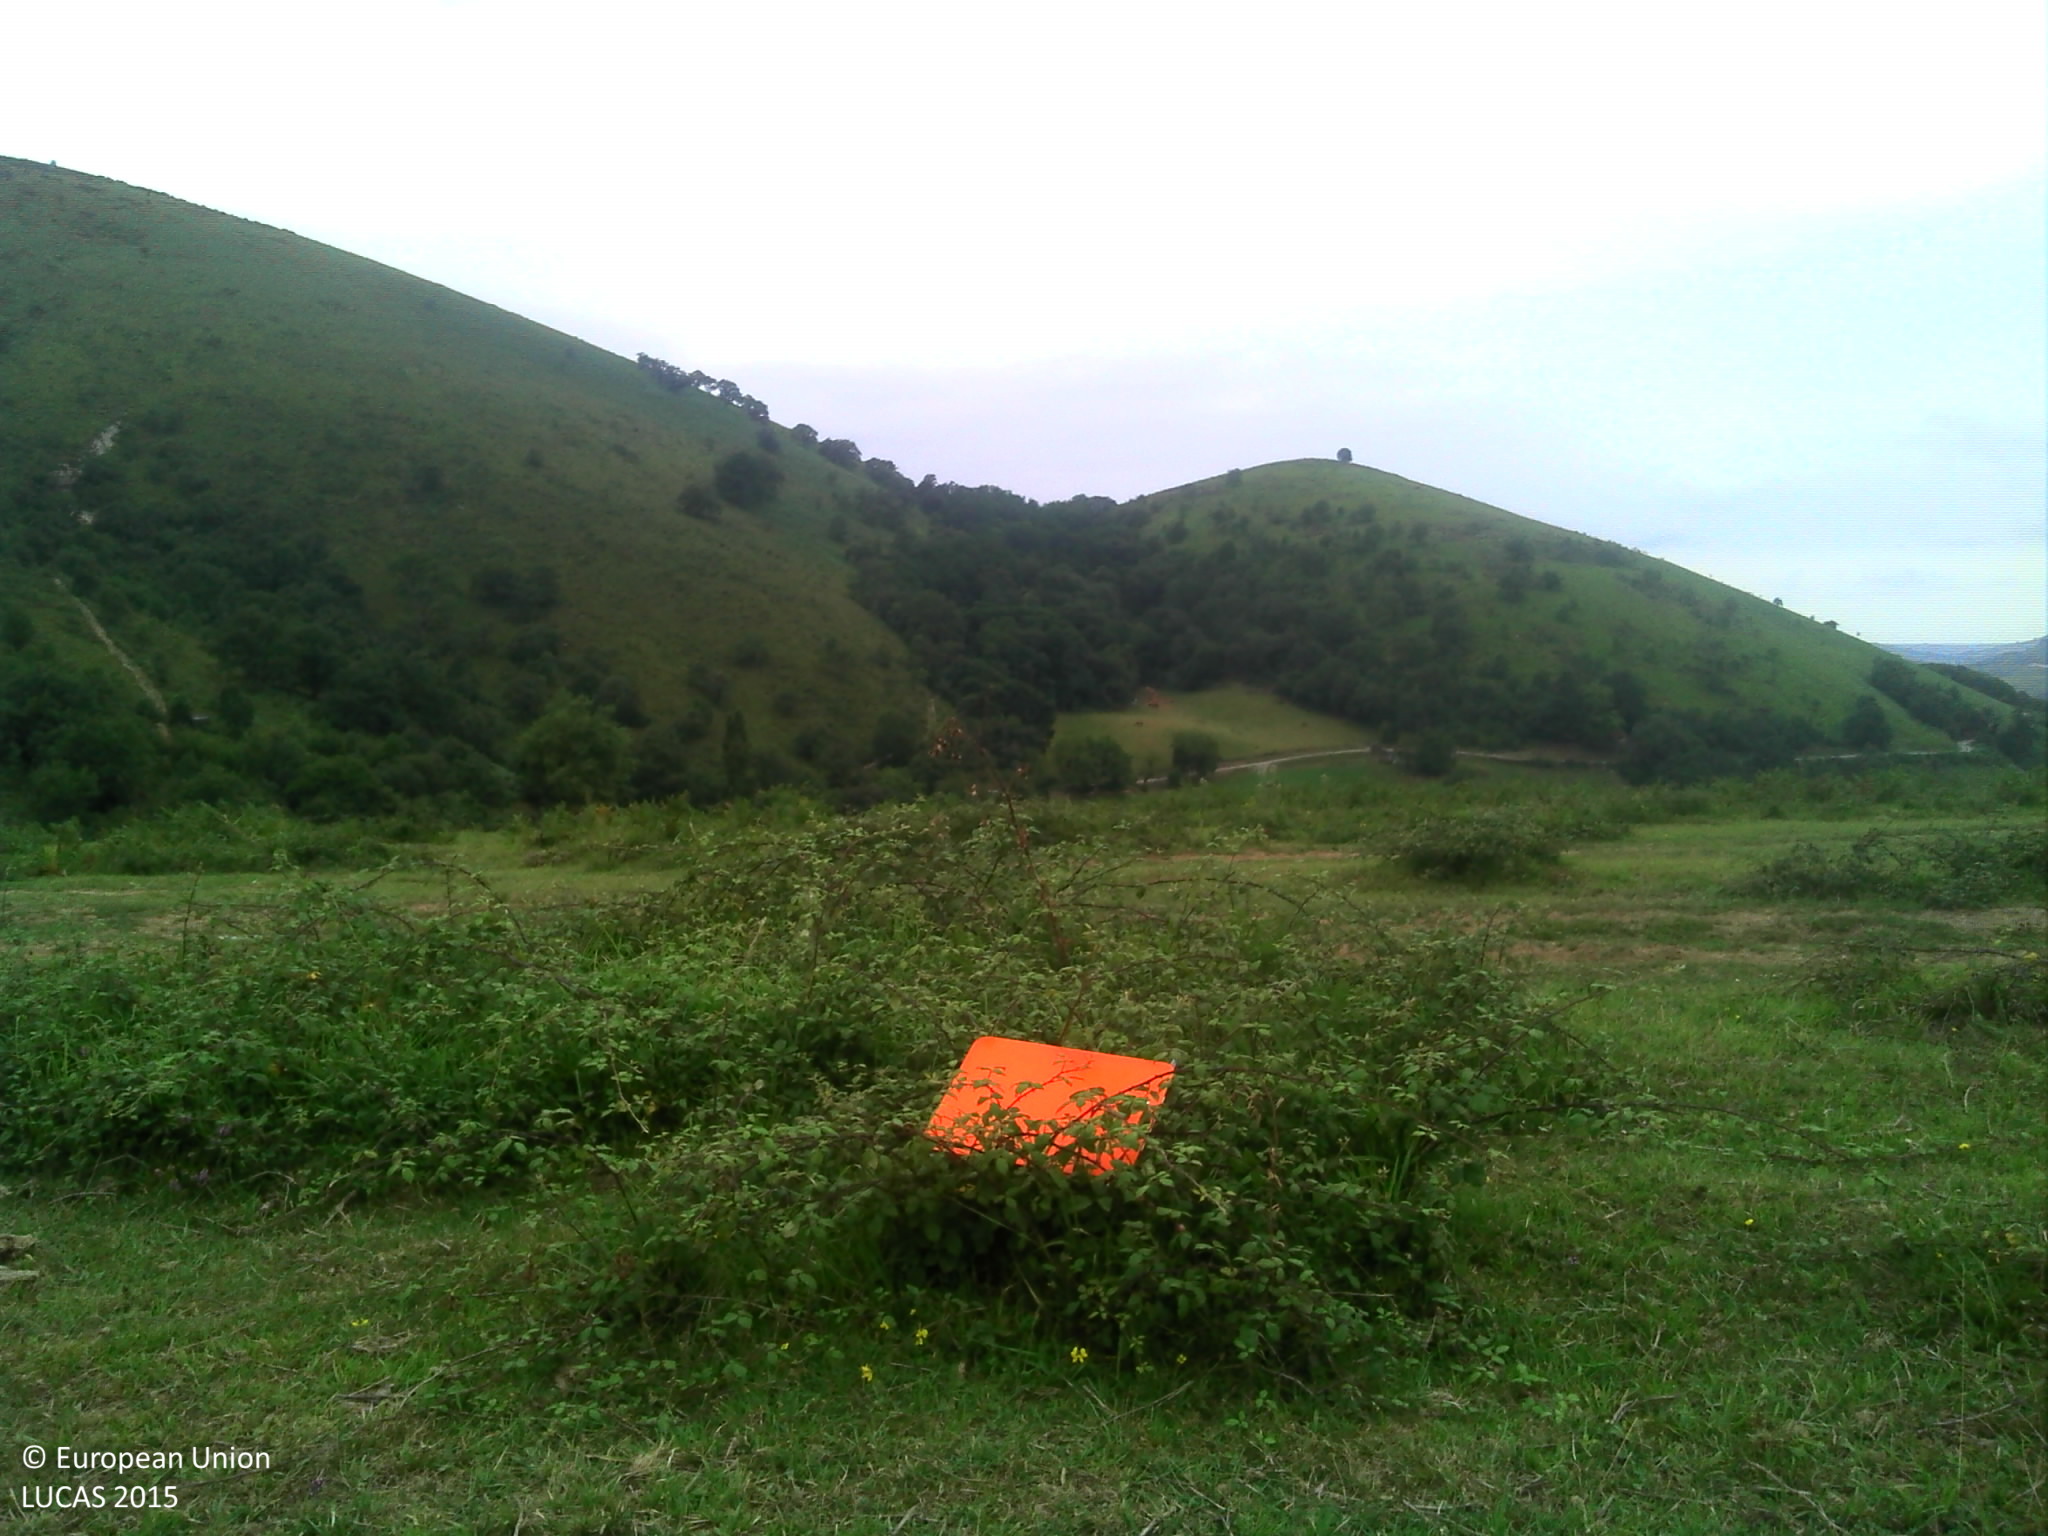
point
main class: Grassland
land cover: Grassland without tree/shrub cover
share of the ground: > 75 %
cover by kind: herbaceous plants 95 %, shrubs 5 %
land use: Agriculture (excluding fallow land and kitchen gardens)
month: August
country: FR
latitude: 43.2552
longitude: -1.1610
